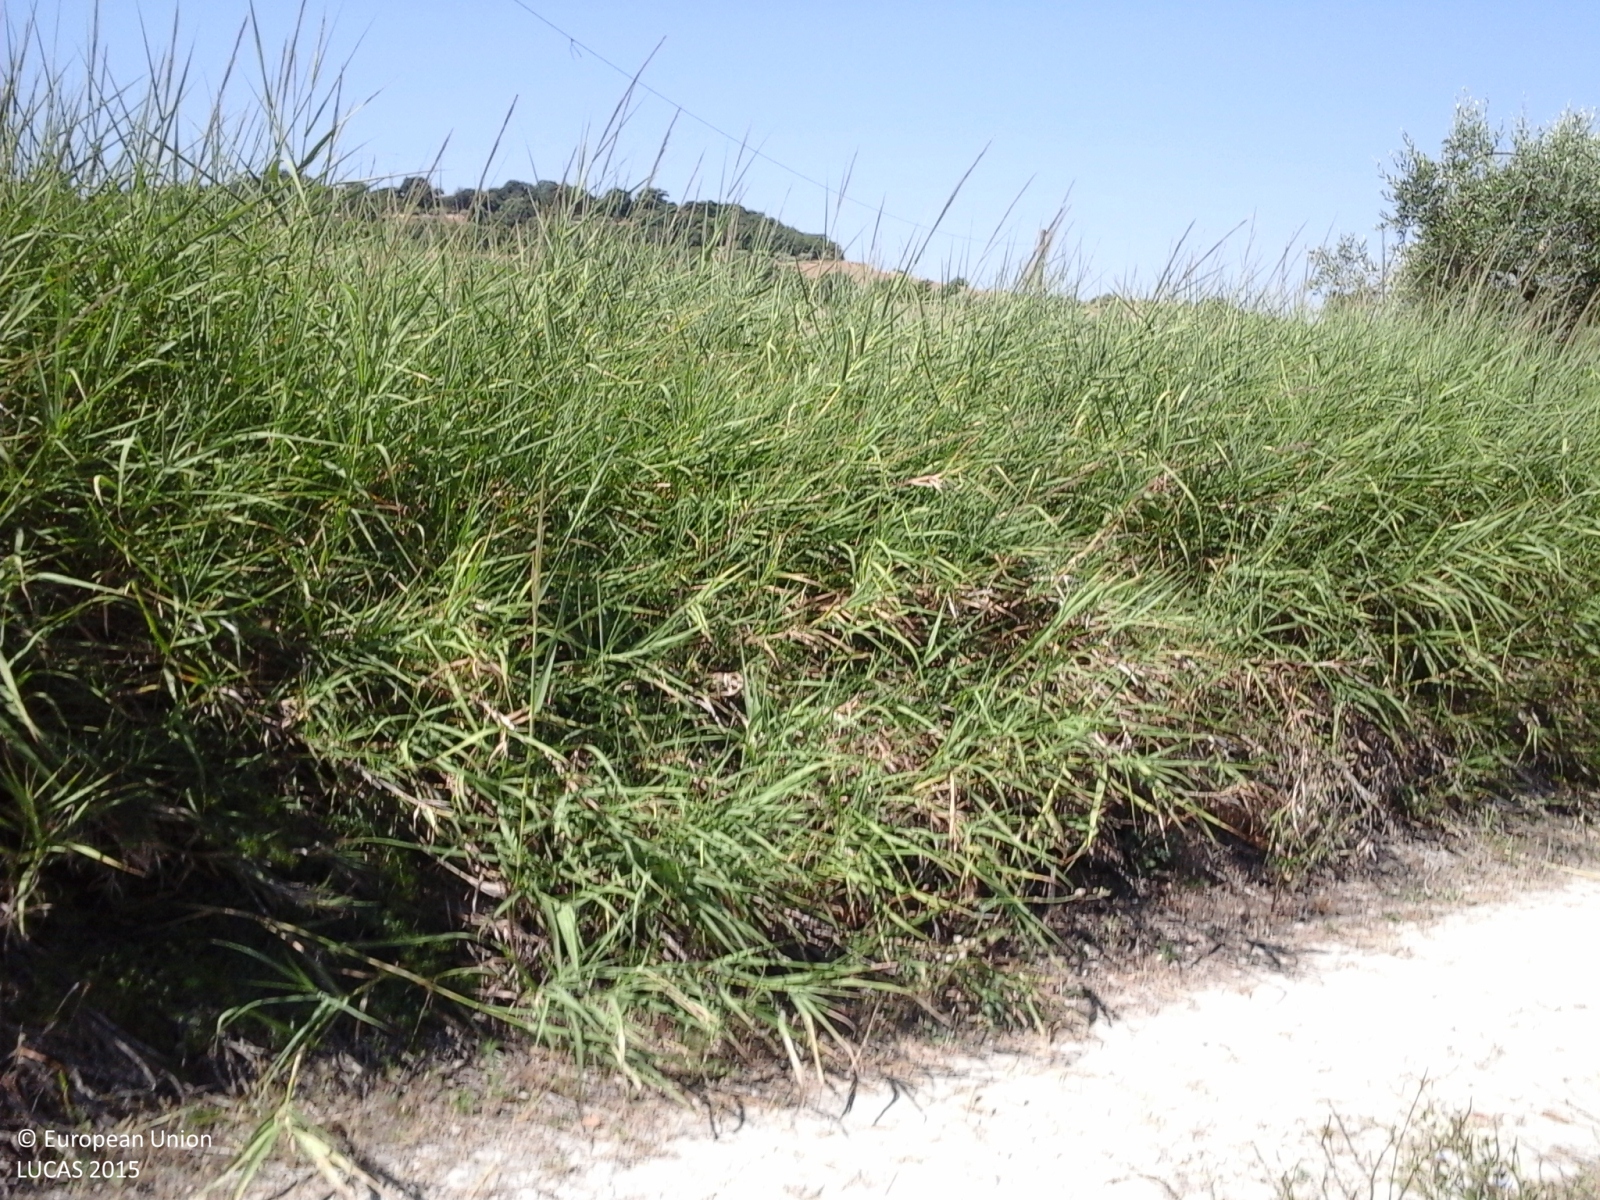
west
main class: Cropland
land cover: Mixed cereals for fodder
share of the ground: > 75 %
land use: Agriculture (excluding fallow land and kitchen gardens)
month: July
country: IT
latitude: 36.9860
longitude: 14.8716
